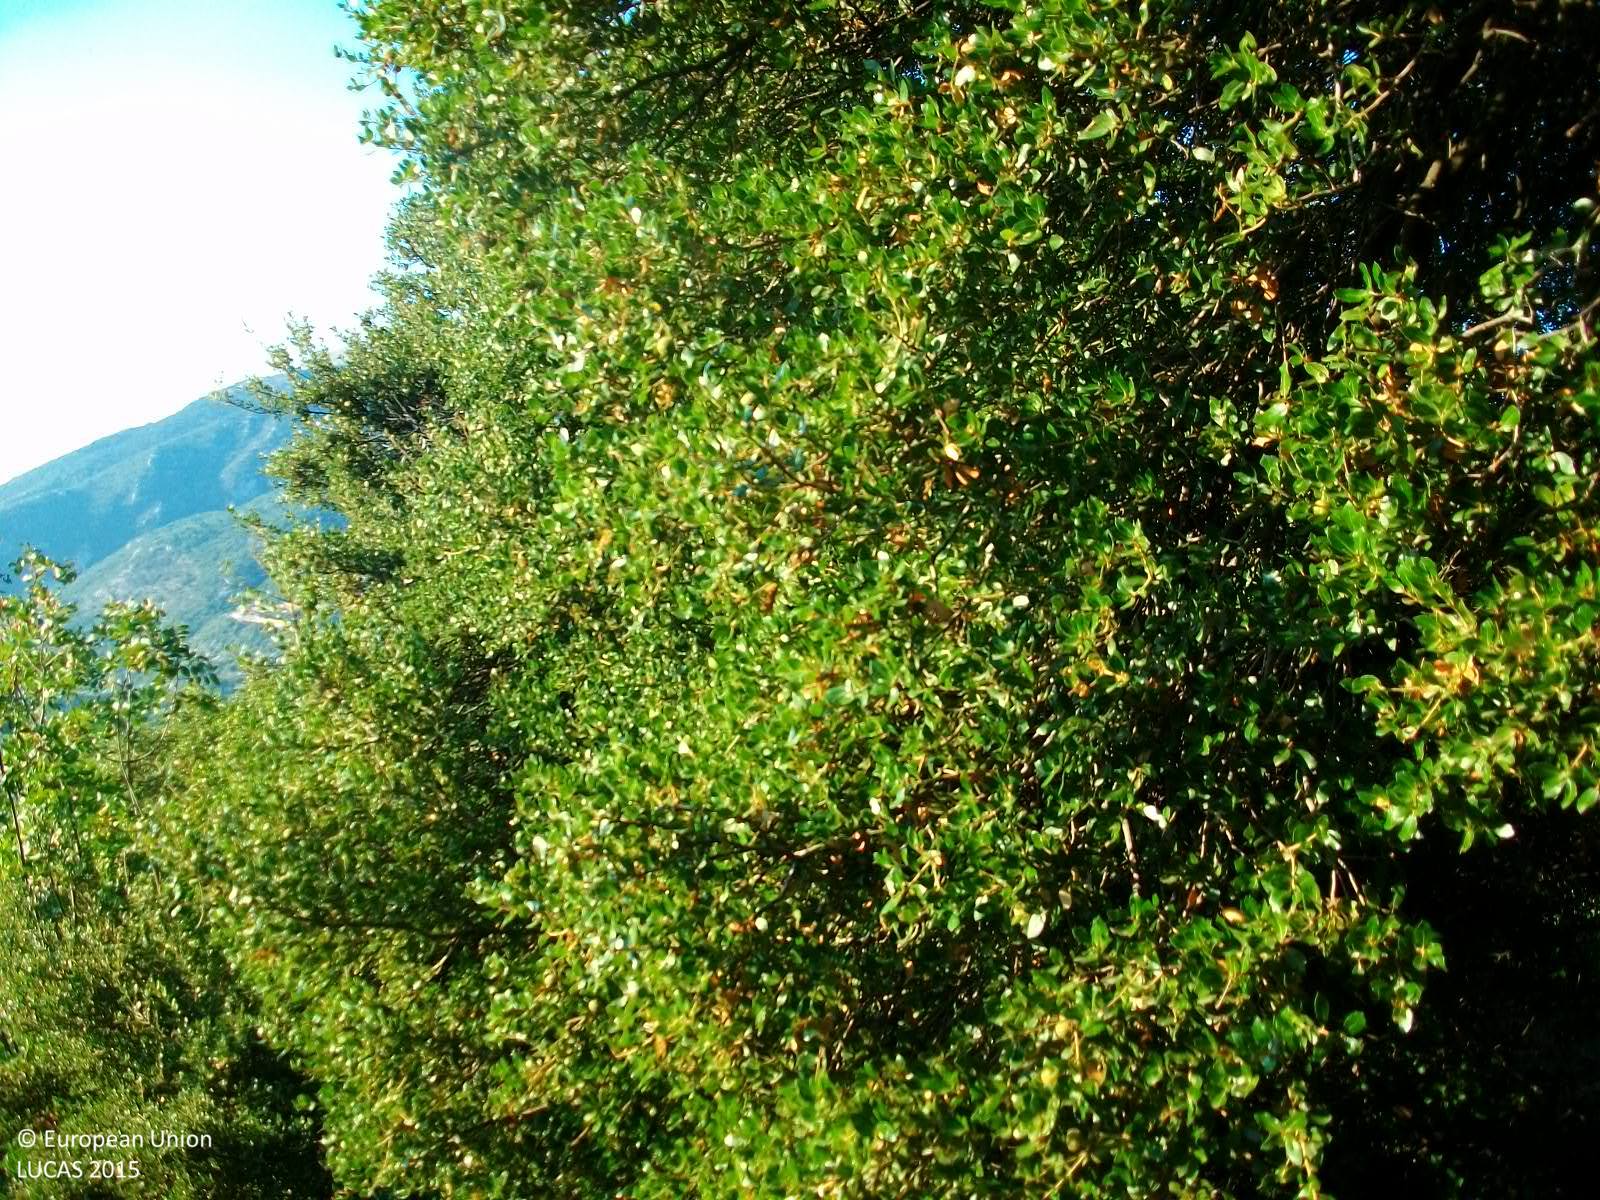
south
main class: Shrubland
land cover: Shrubland without tree cover
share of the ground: > 75 %
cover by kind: shrubs 100 %
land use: Semi-natural and natural areas not in use
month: August
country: GR
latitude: 37.1852
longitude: 22.2912
